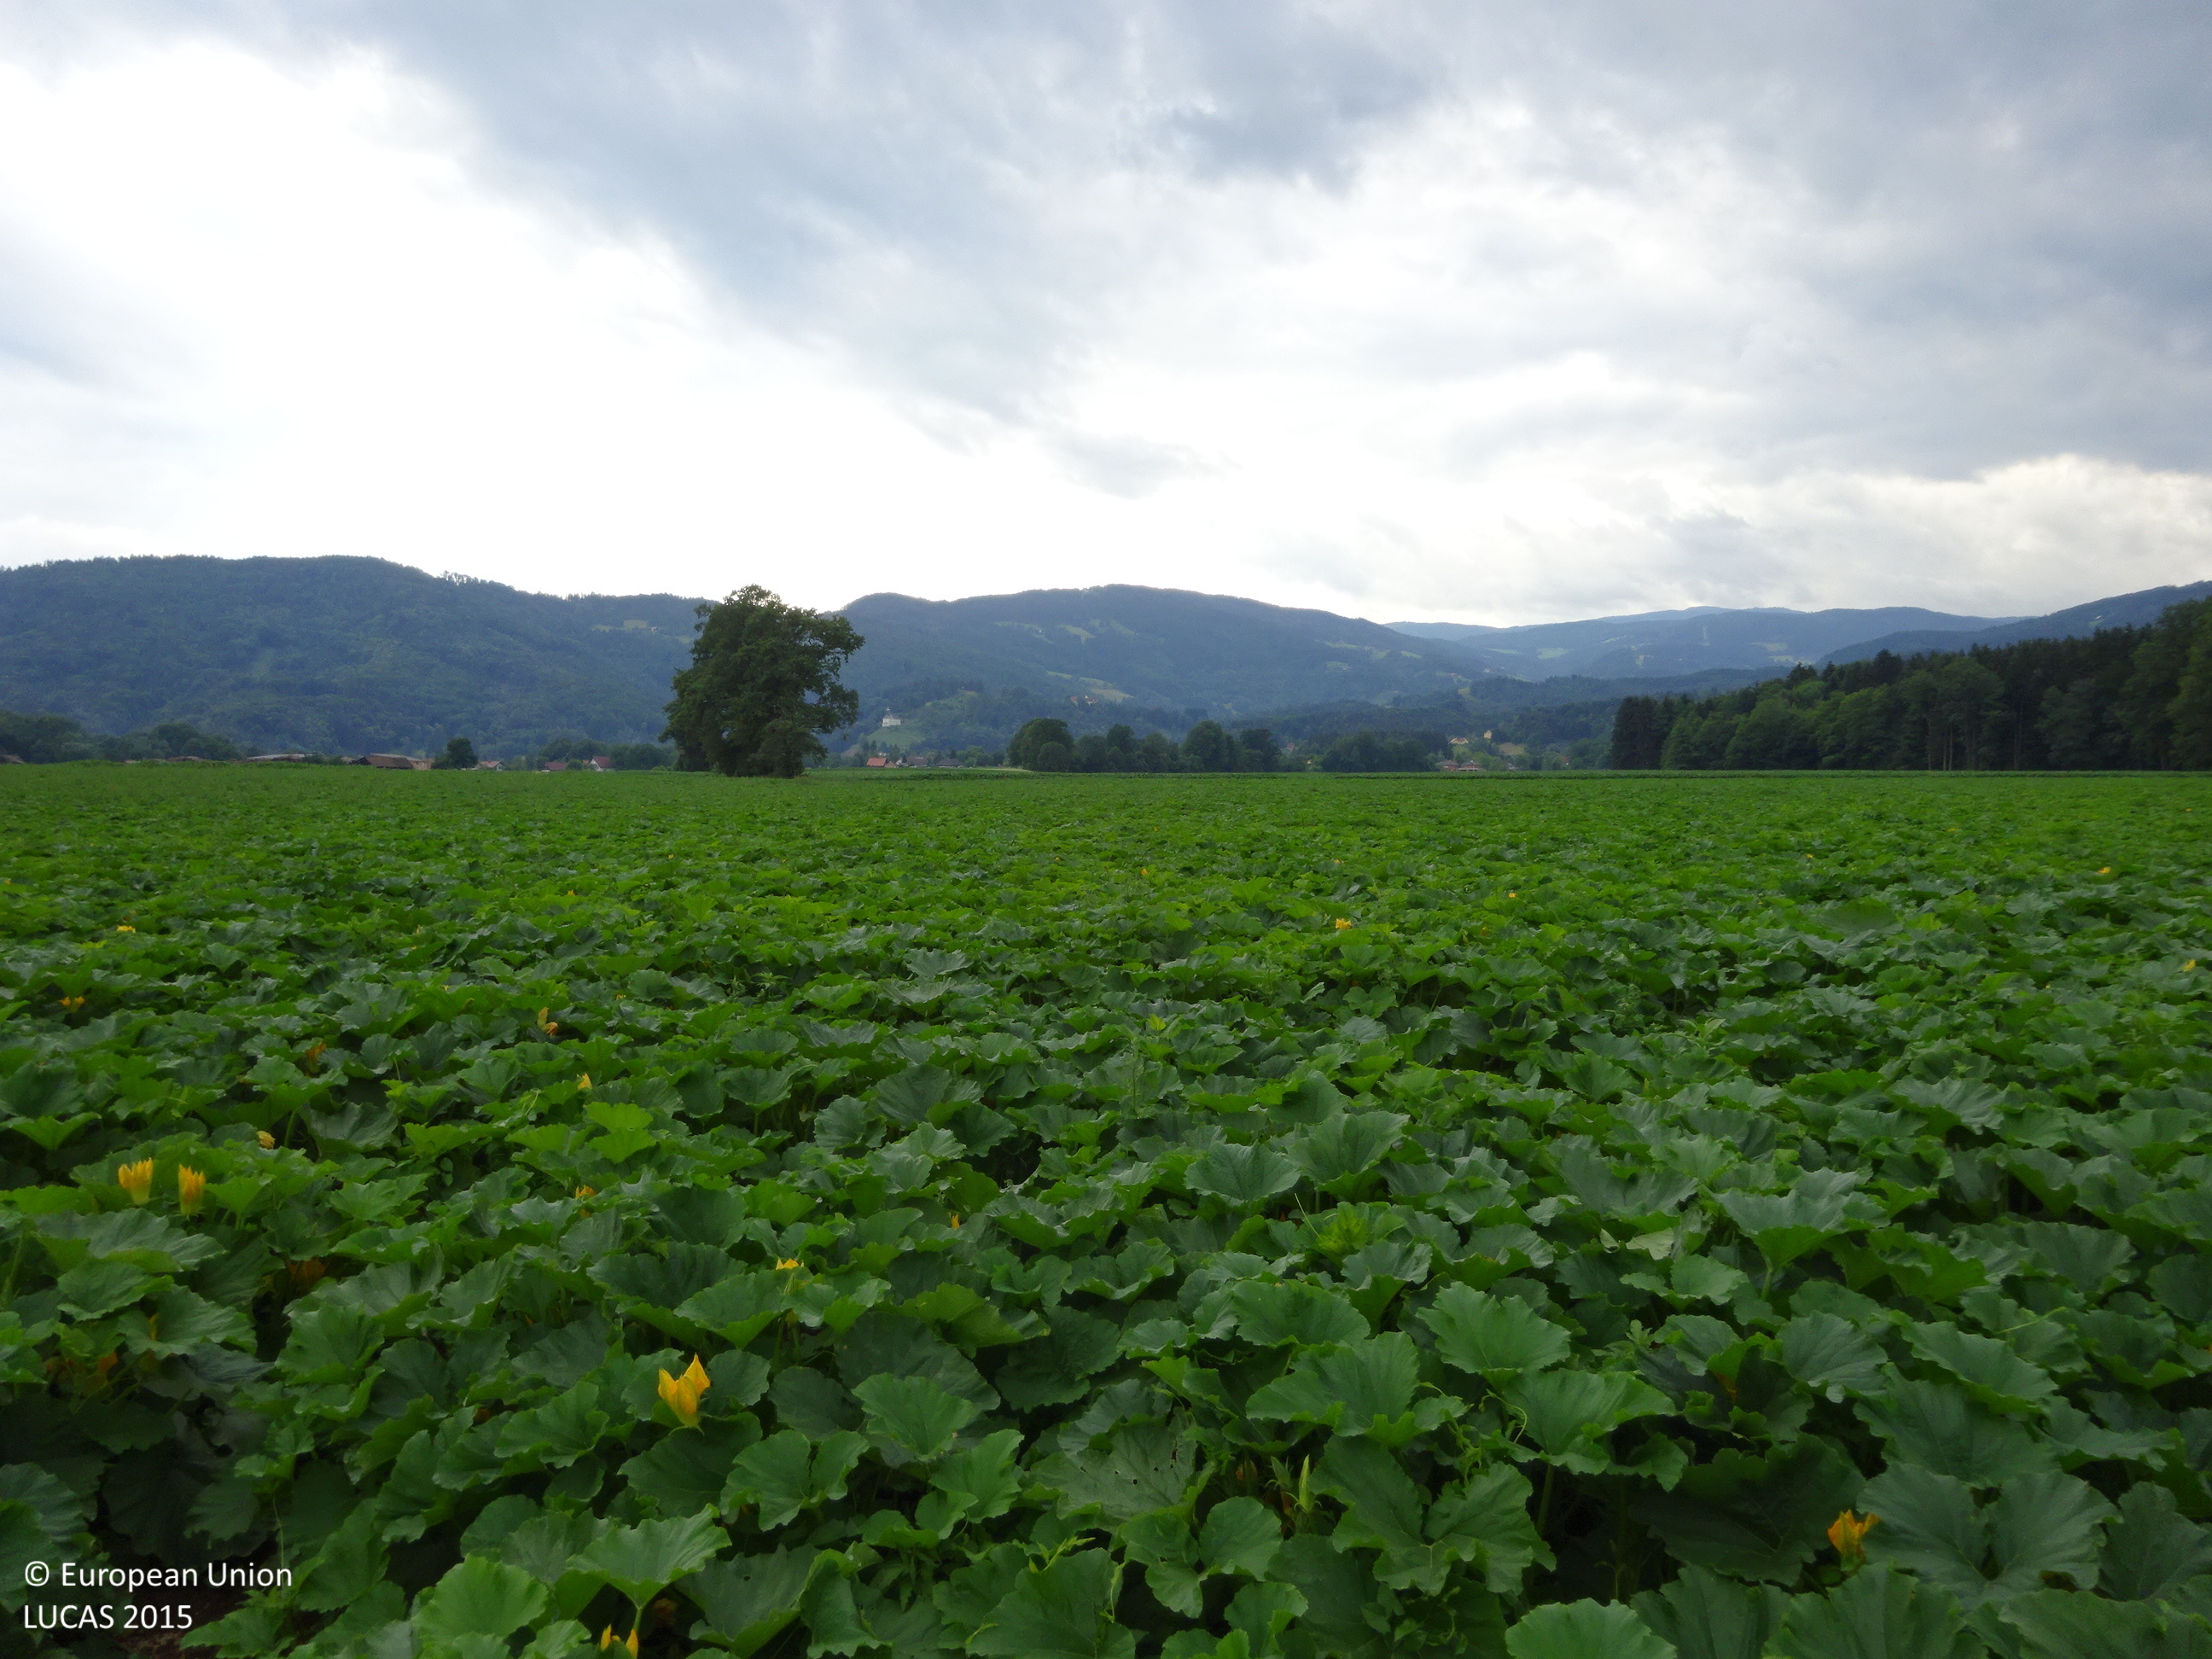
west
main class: Cropland
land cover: Other fresh vegetables
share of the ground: > 75 %
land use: Agriculture (excluding fallow land and kitchen gardens)
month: June
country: AT
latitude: 46.7650
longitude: 15.2233
